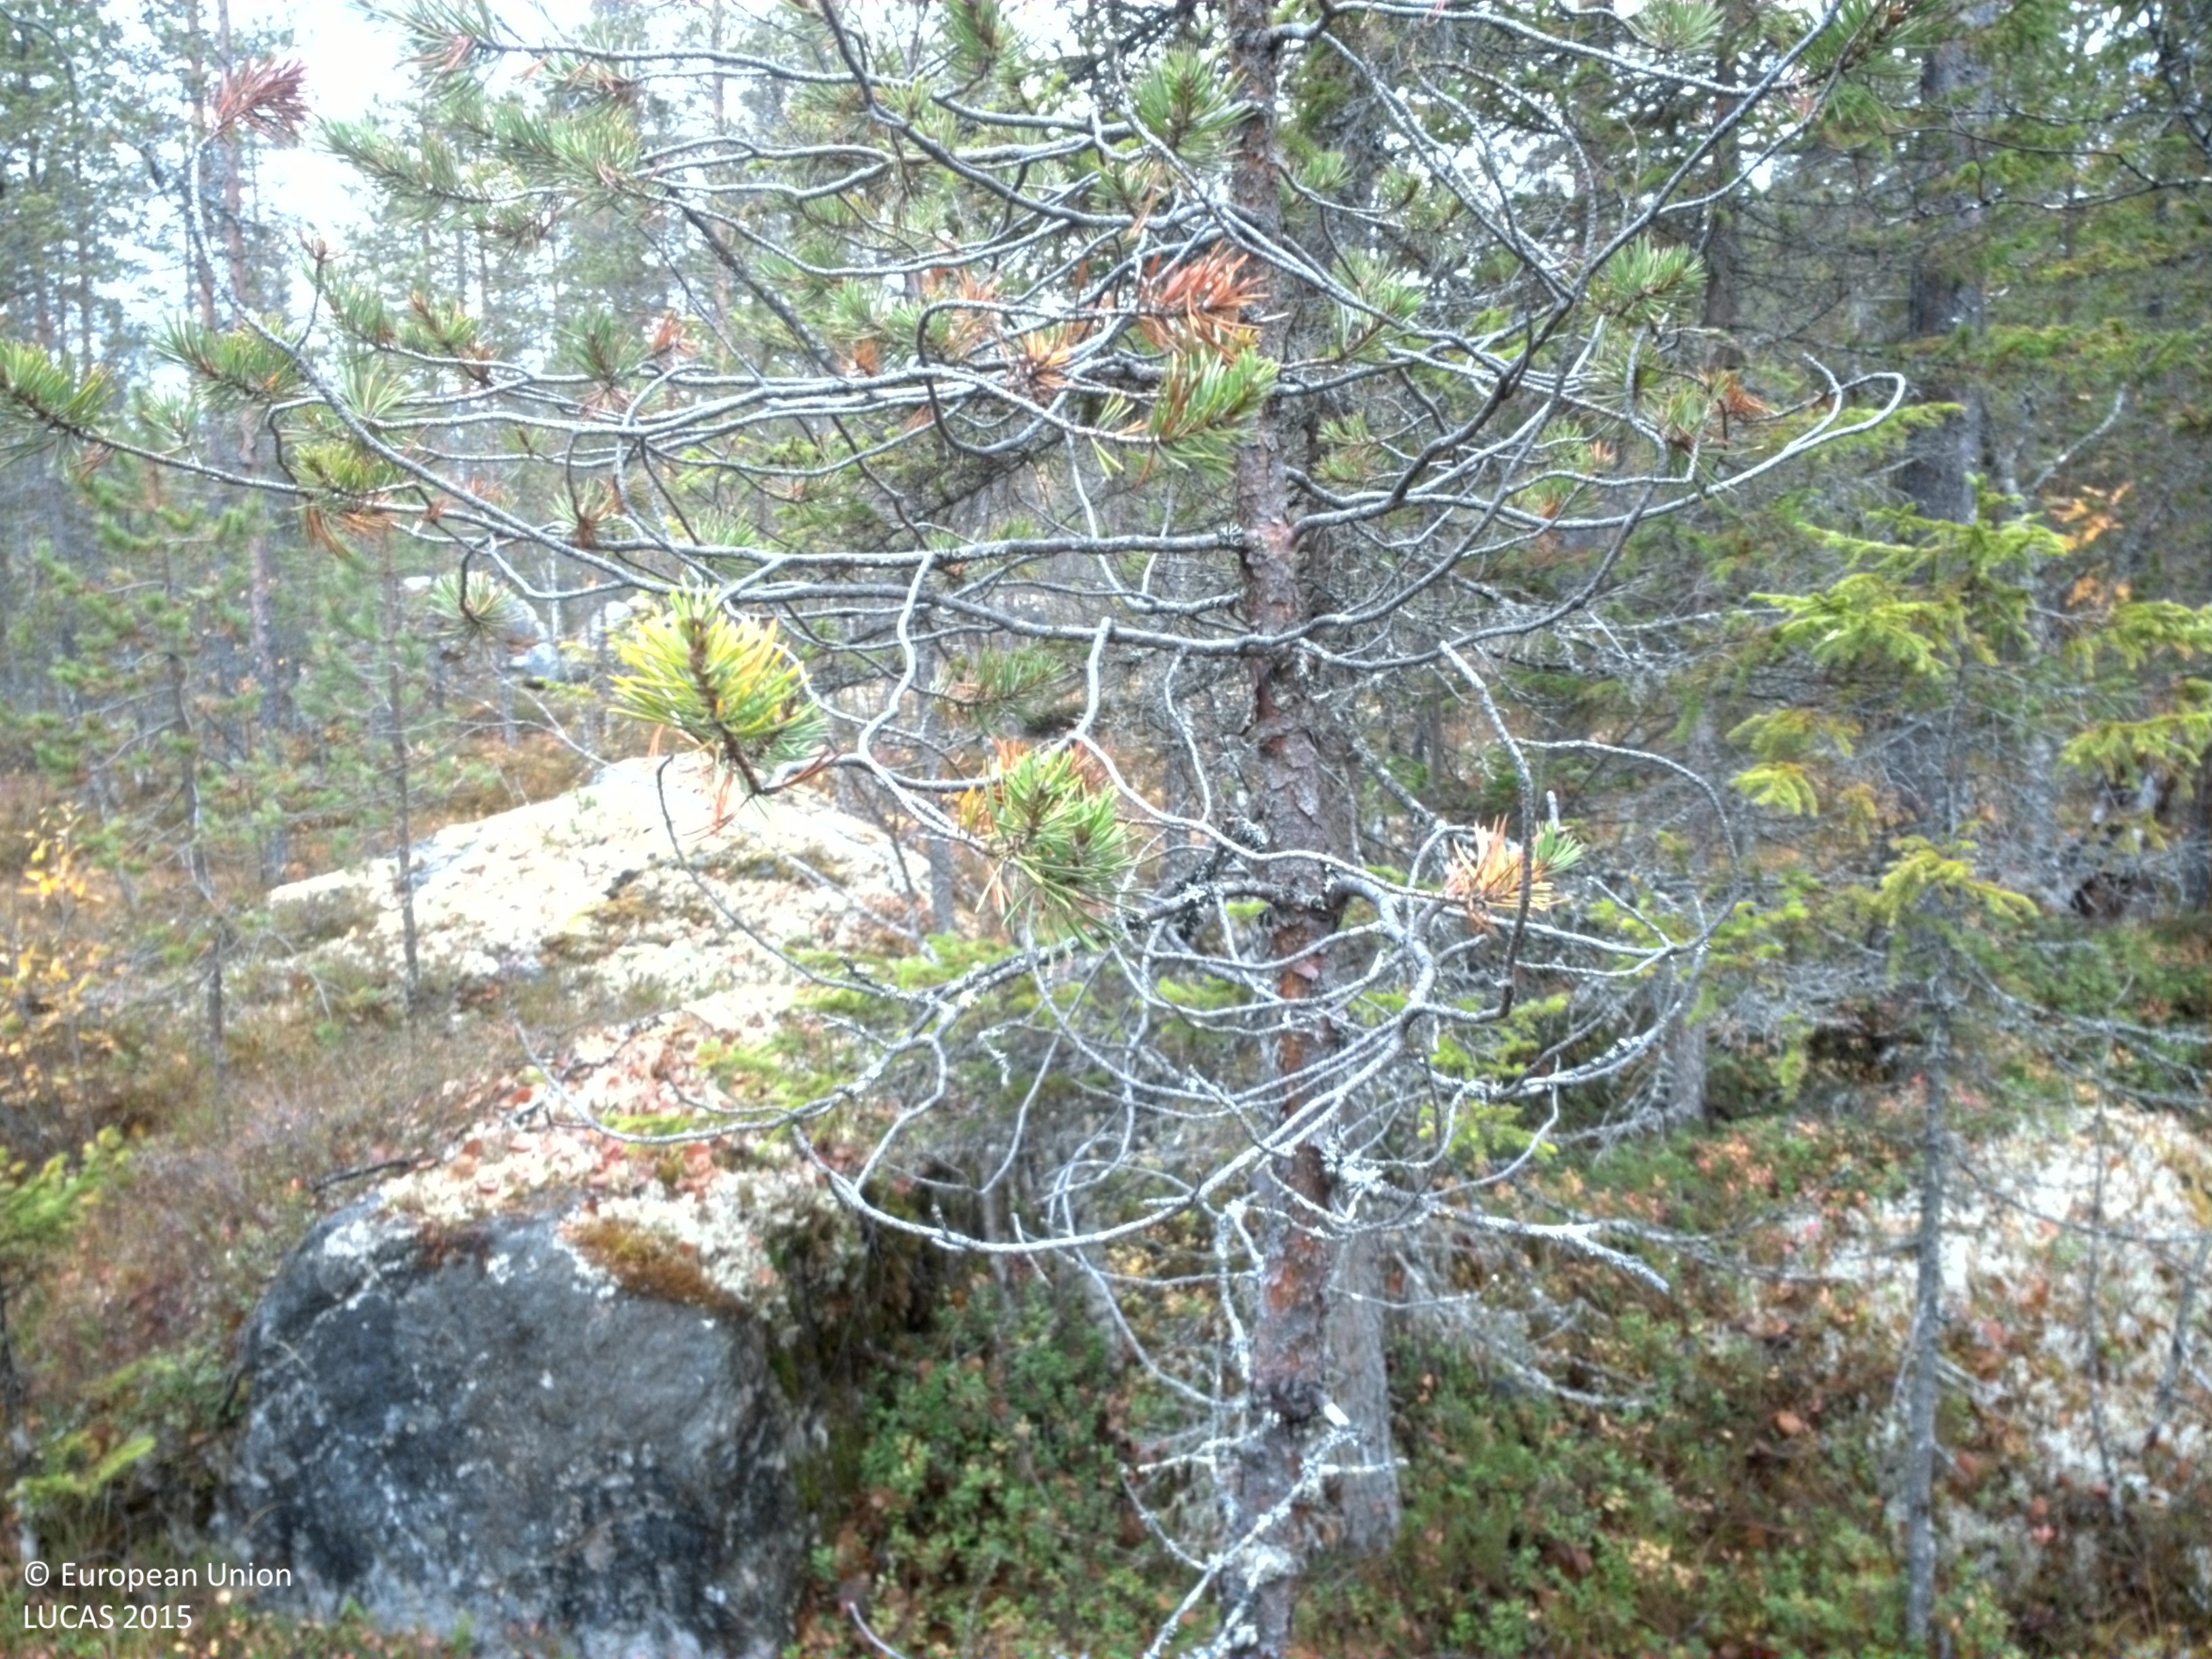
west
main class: Woodland
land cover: Pine dominated coniferous woodland
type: boreal forest
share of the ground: 25 - 50 %
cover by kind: coniferous forest trees 30 %, shrubs 25 %, lichens and mosses 25 %, herbaceous plants 15 %, broadleaved forest trees 5 %
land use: Forestry
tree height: > 5 m
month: October
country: SE
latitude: 64.9640
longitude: 17.5244
